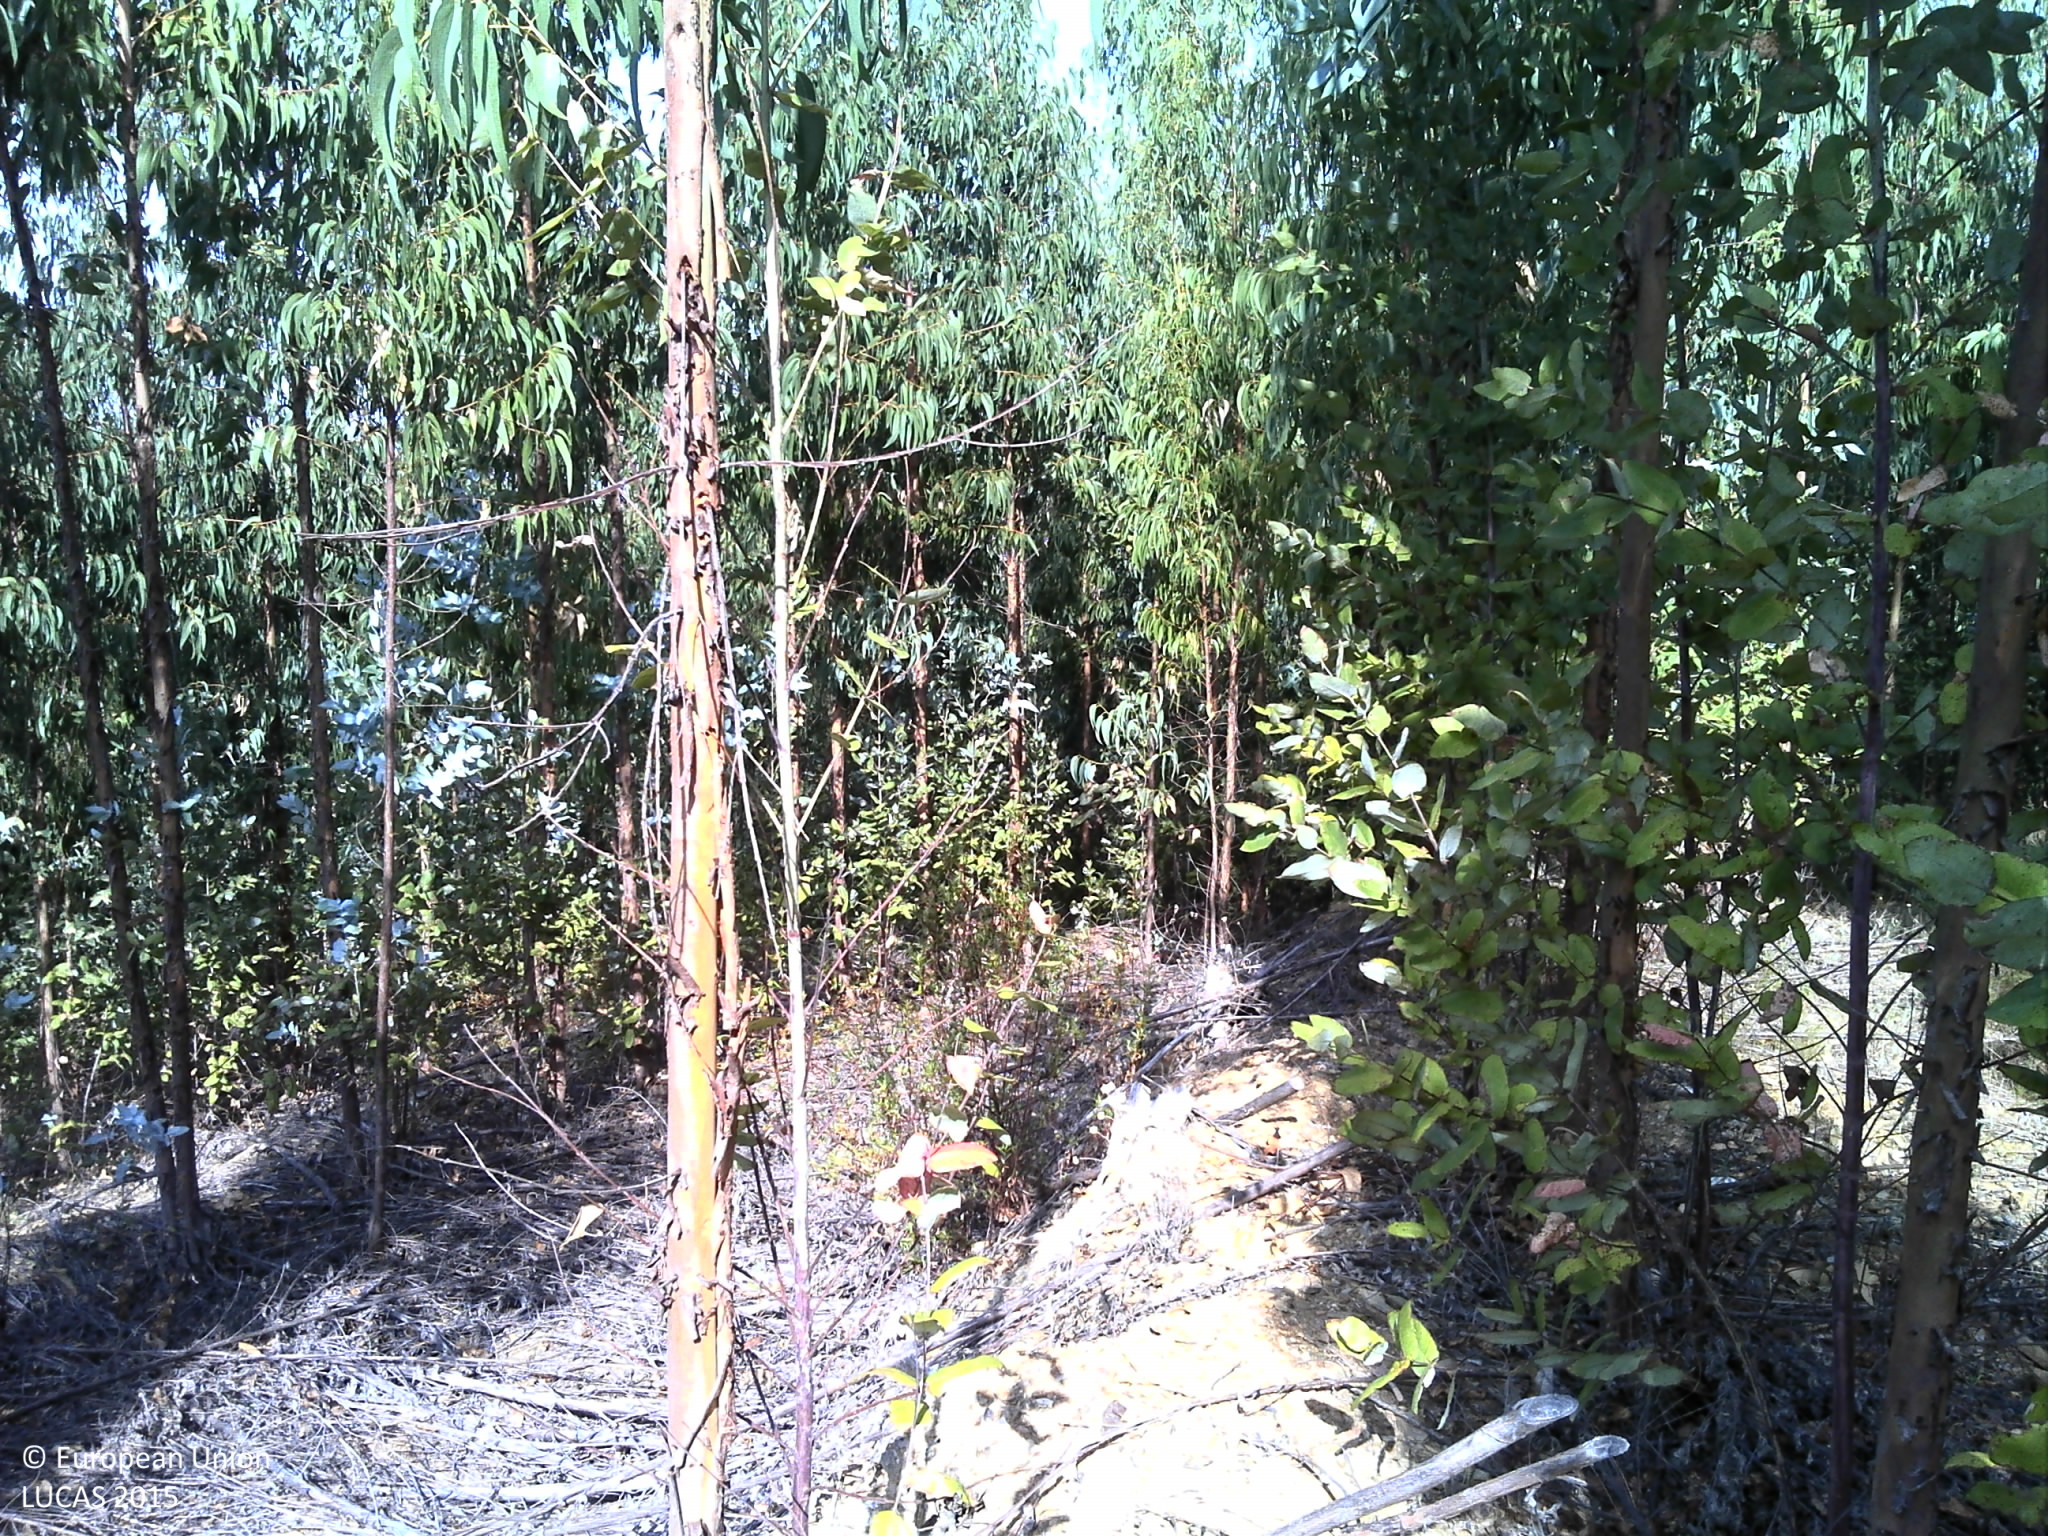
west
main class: Woodland
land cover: Broadleaved woodland
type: exotic forest
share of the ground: 50 - 75 %
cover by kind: broadleaved forest trees 50 %, consolidated bare surface 45 %, herbaceous plants 5 %
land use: Forestry
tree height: > 5 m
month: July
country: PT
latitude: 37.6790
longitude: -8.4839
